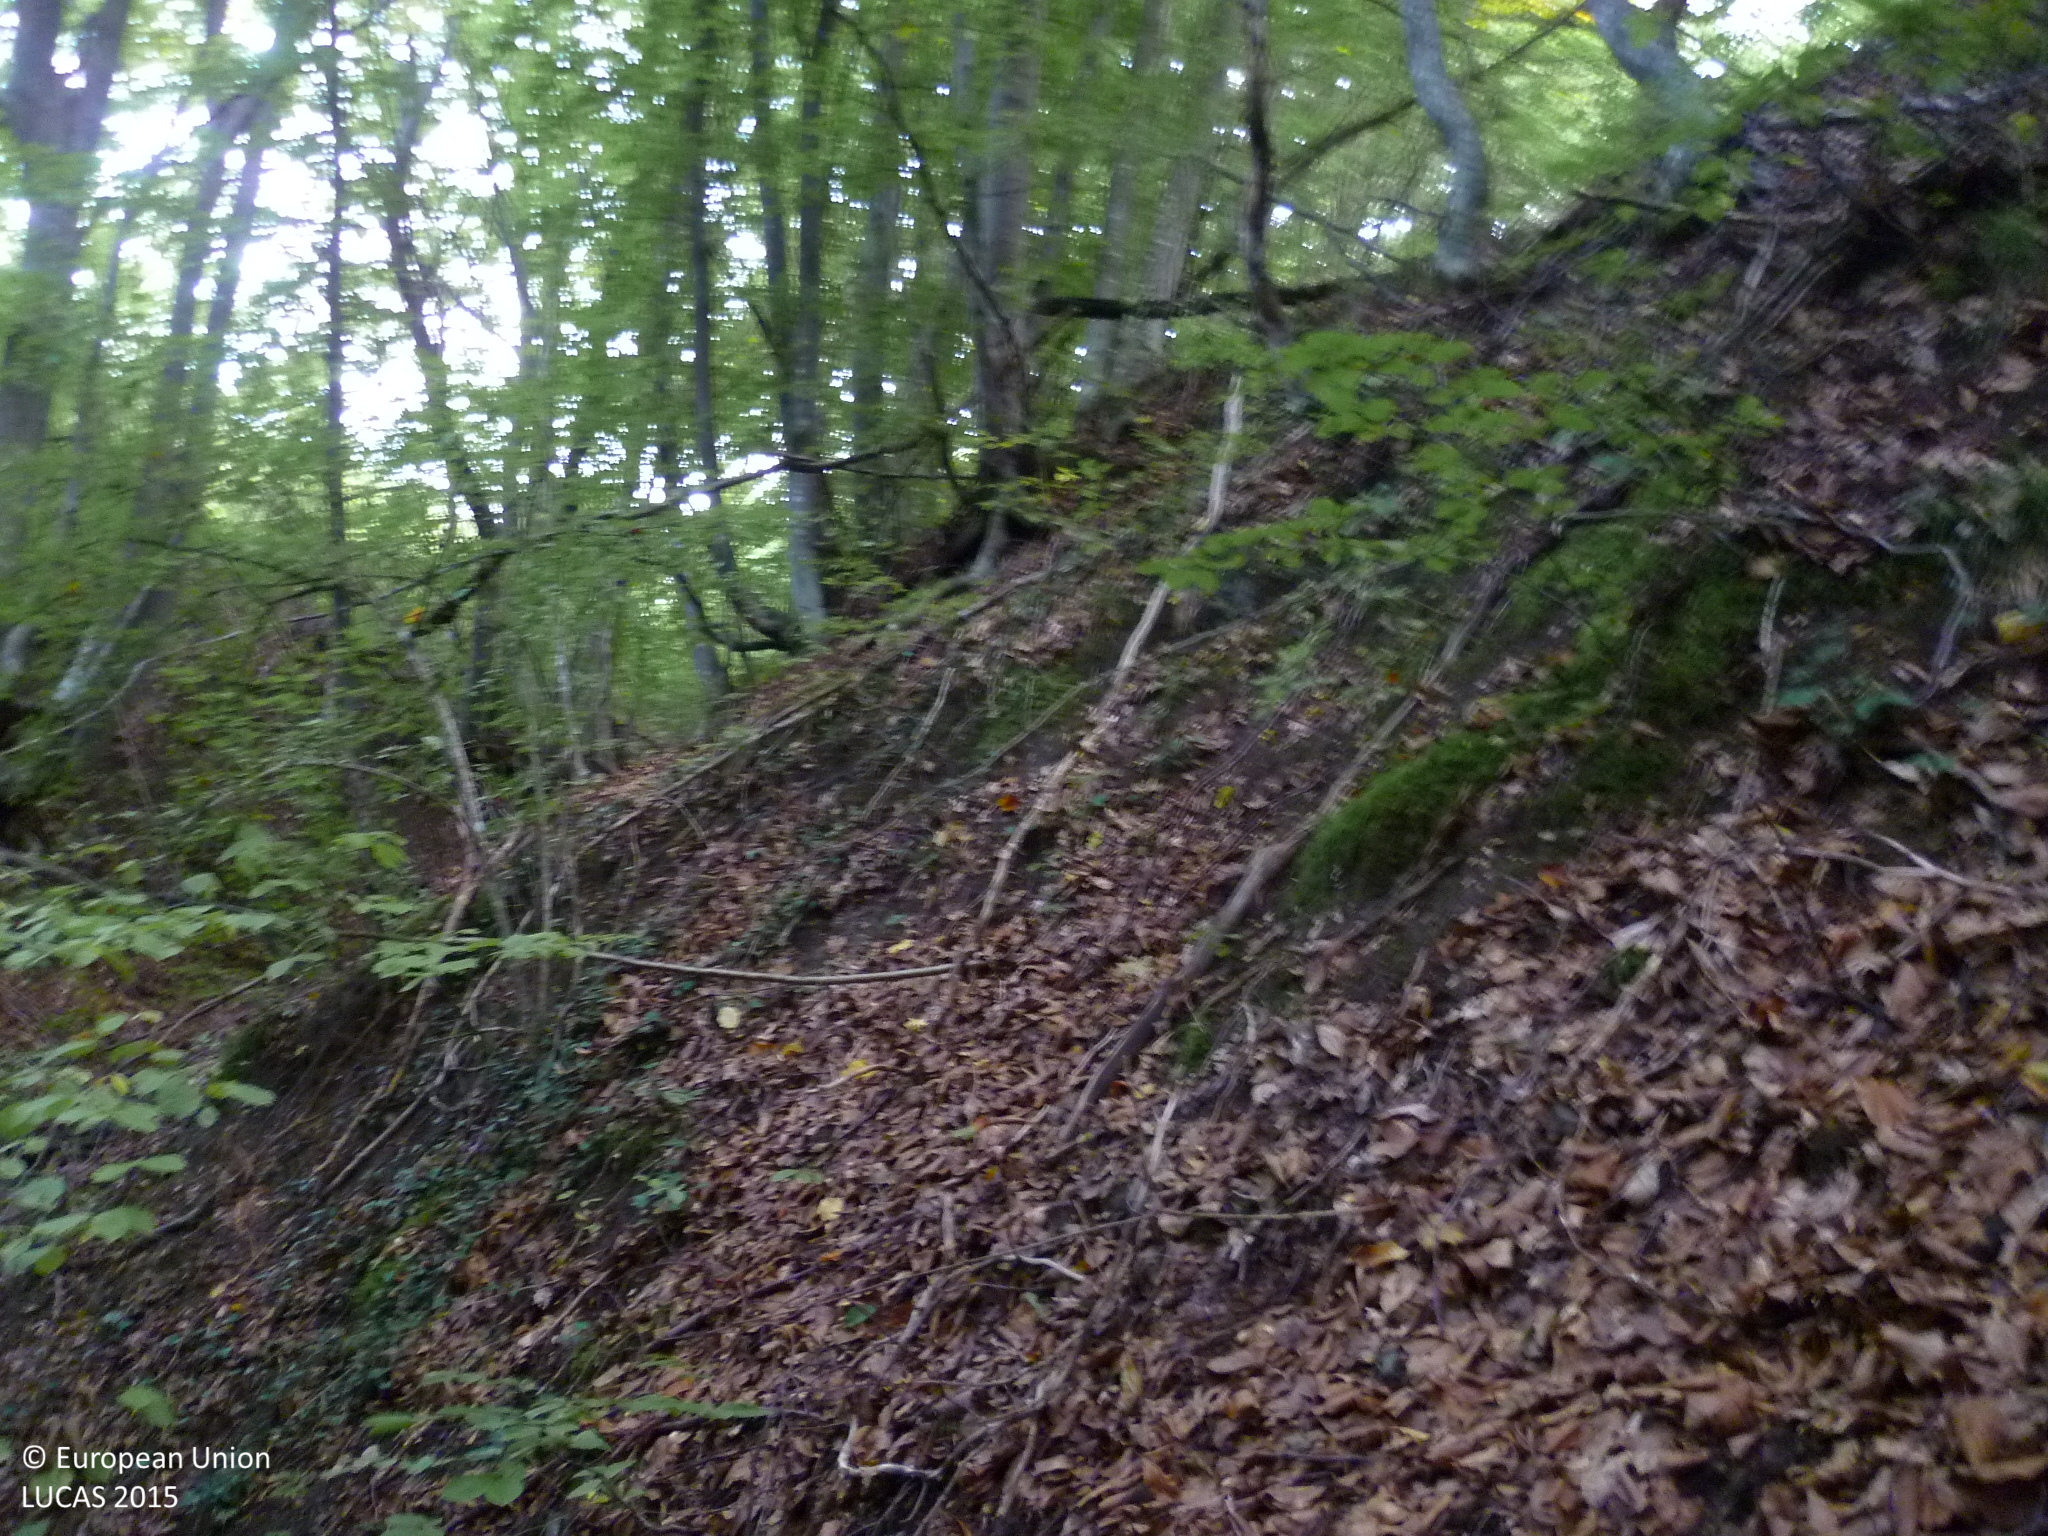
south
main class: Woodland
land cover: Broadleaved woodland
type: beech forest
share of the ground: 50 - 75 %
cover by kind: broadleaved forest trees 70 %, unconsolidated bare surface 20 %, lichens and mosses 10 %
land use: Forestry
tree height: > 5 m
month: October
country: BG
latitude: 42.8559
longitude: 22.6937
